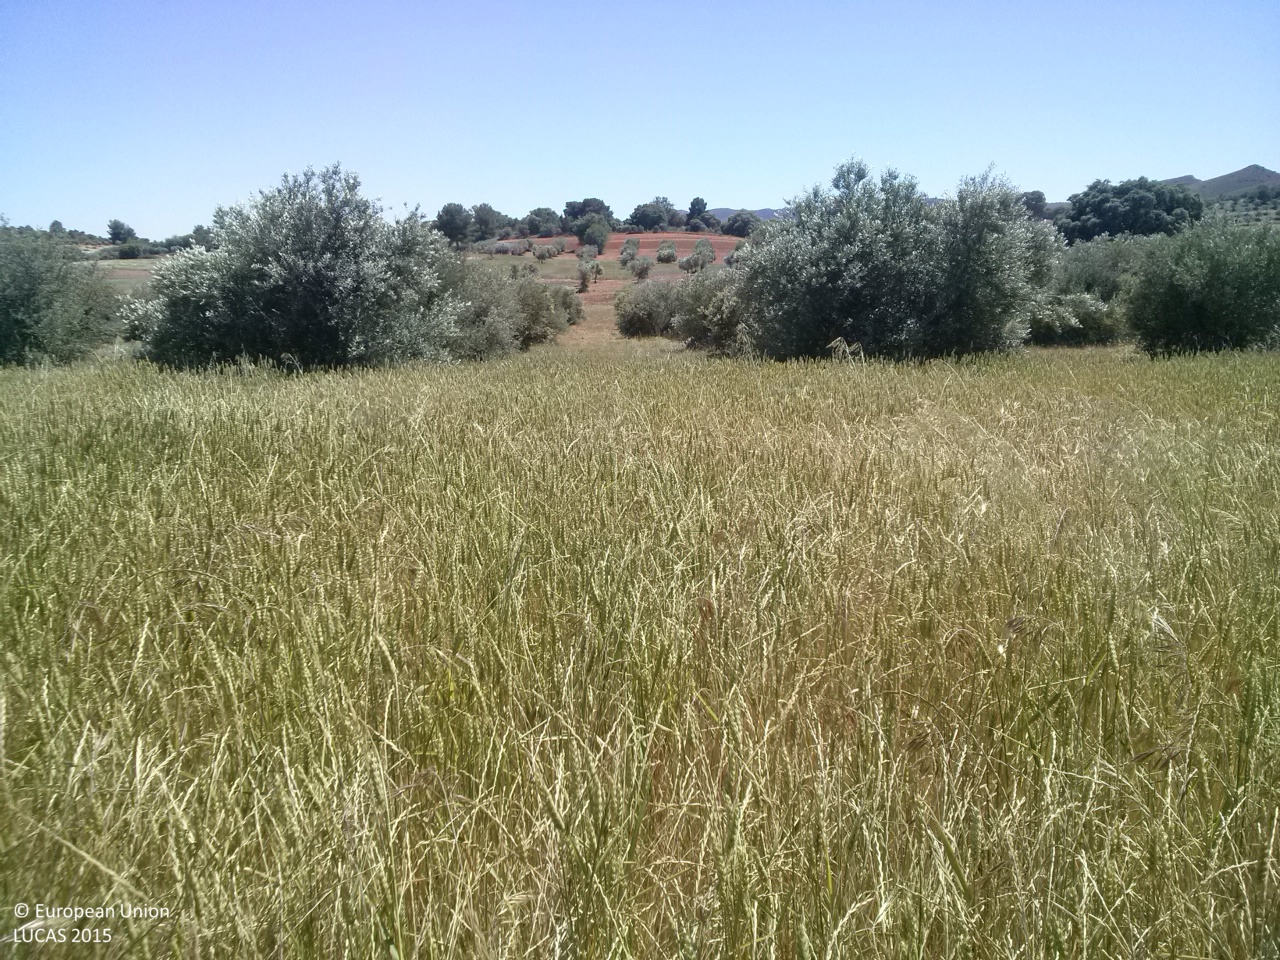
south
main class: Cropland
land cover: Common wheat
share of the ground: > 75 %
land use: Agriculture (excluding fallow land and kitchen gardens)
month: May
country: ES
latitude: 40.3430
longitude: -2.7749
